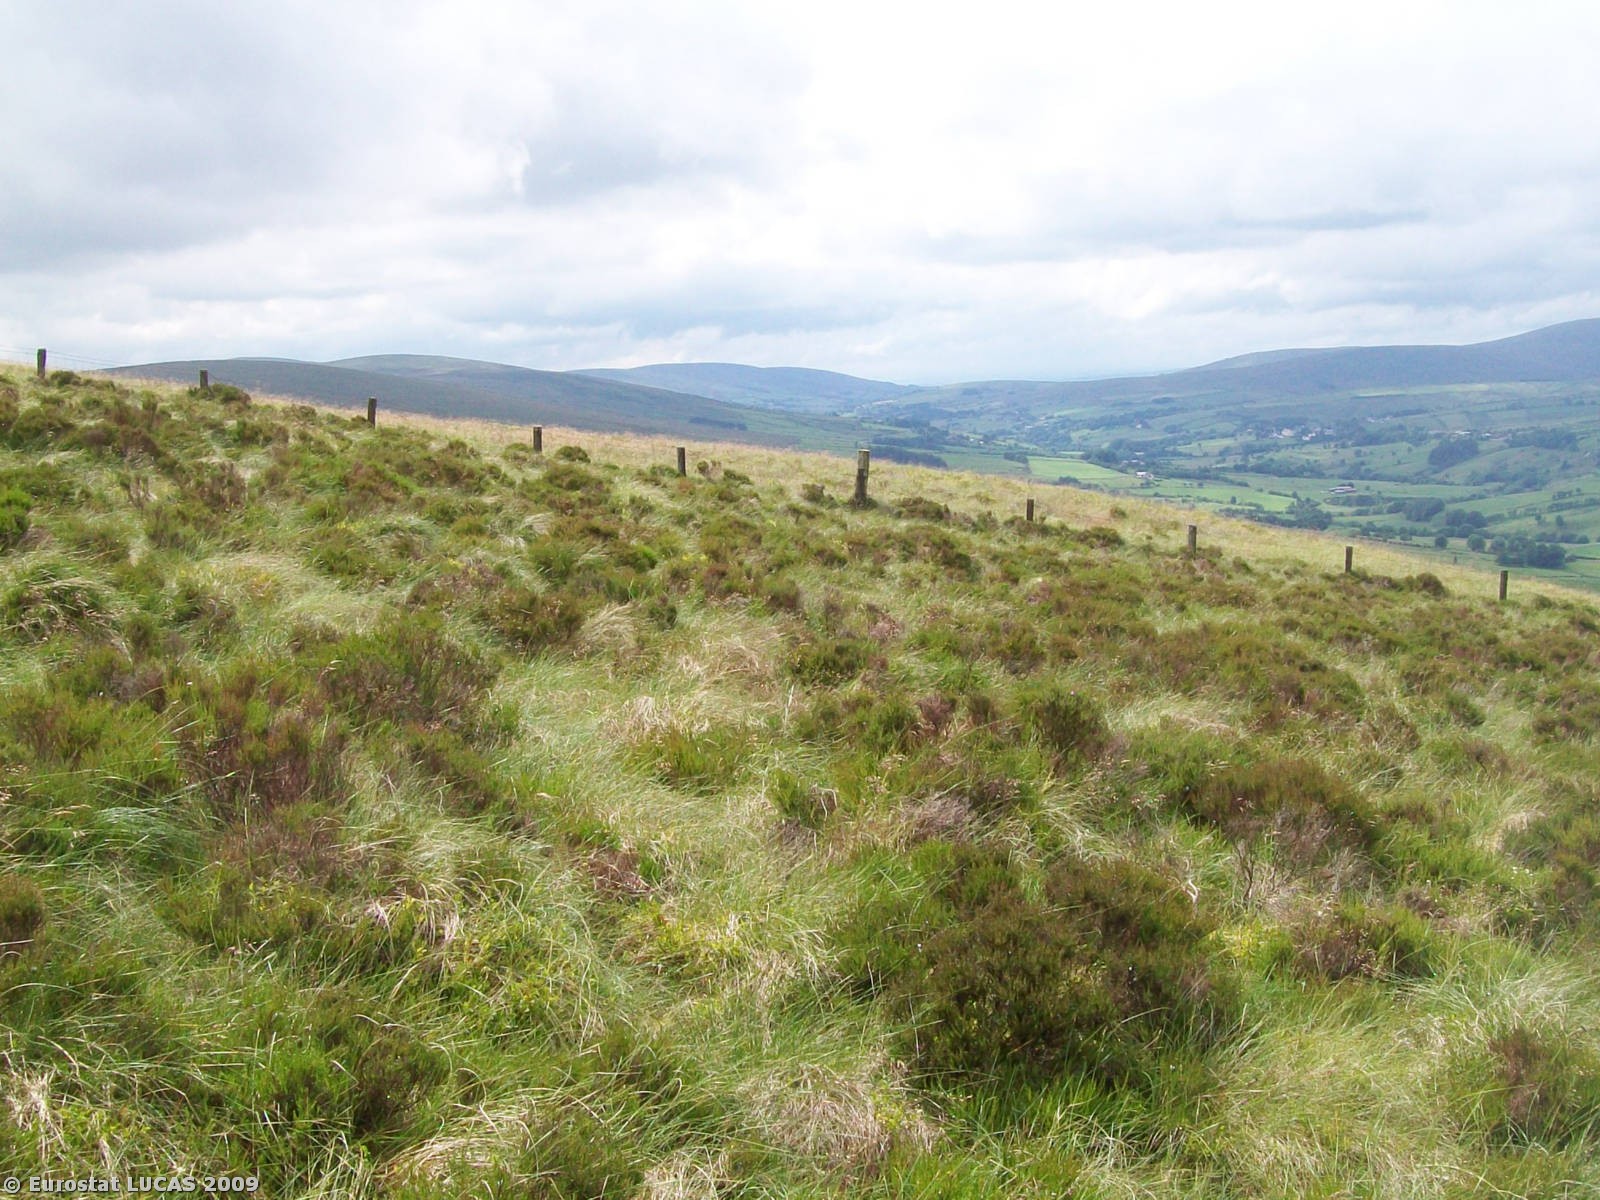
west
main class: Wetlands
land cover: Peatbogs
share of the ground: > 75 %
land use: Unused
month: July
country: GB
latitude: 54.7681
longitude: -6.9713
